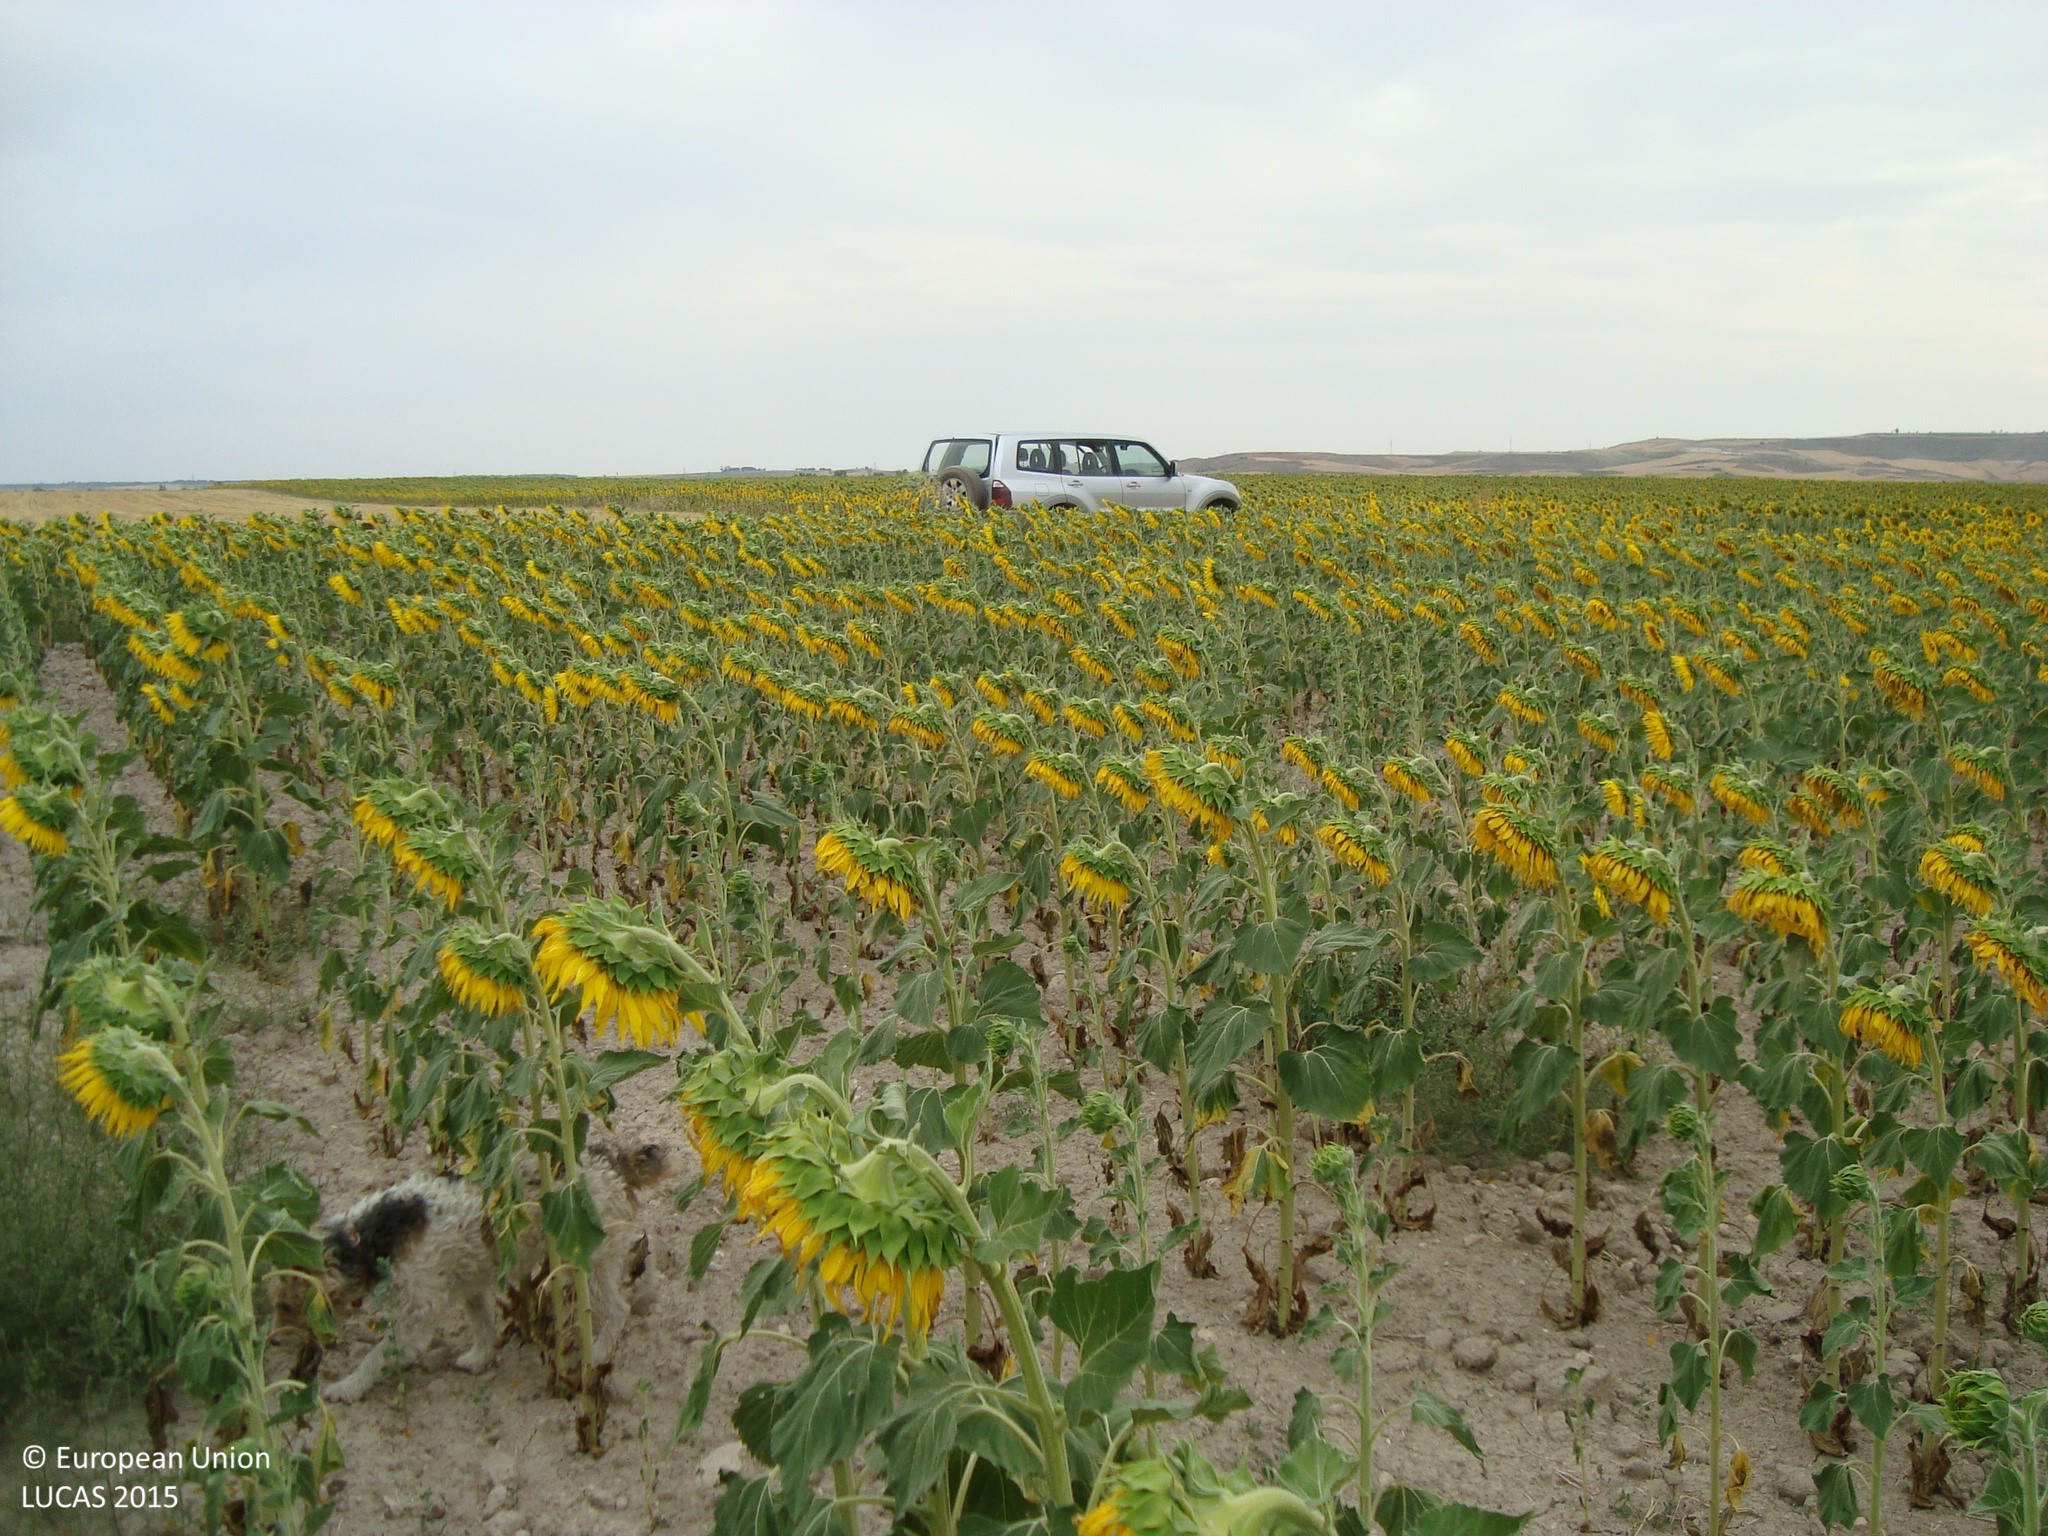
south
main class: Cropland
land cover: Sunflower
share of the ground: 50 - 75 %
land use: Agriculture (excluding fallow land and kitchen gardens)
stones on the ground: < 10 %
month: August
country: ES
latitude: 42.1953
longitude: -3.9529
